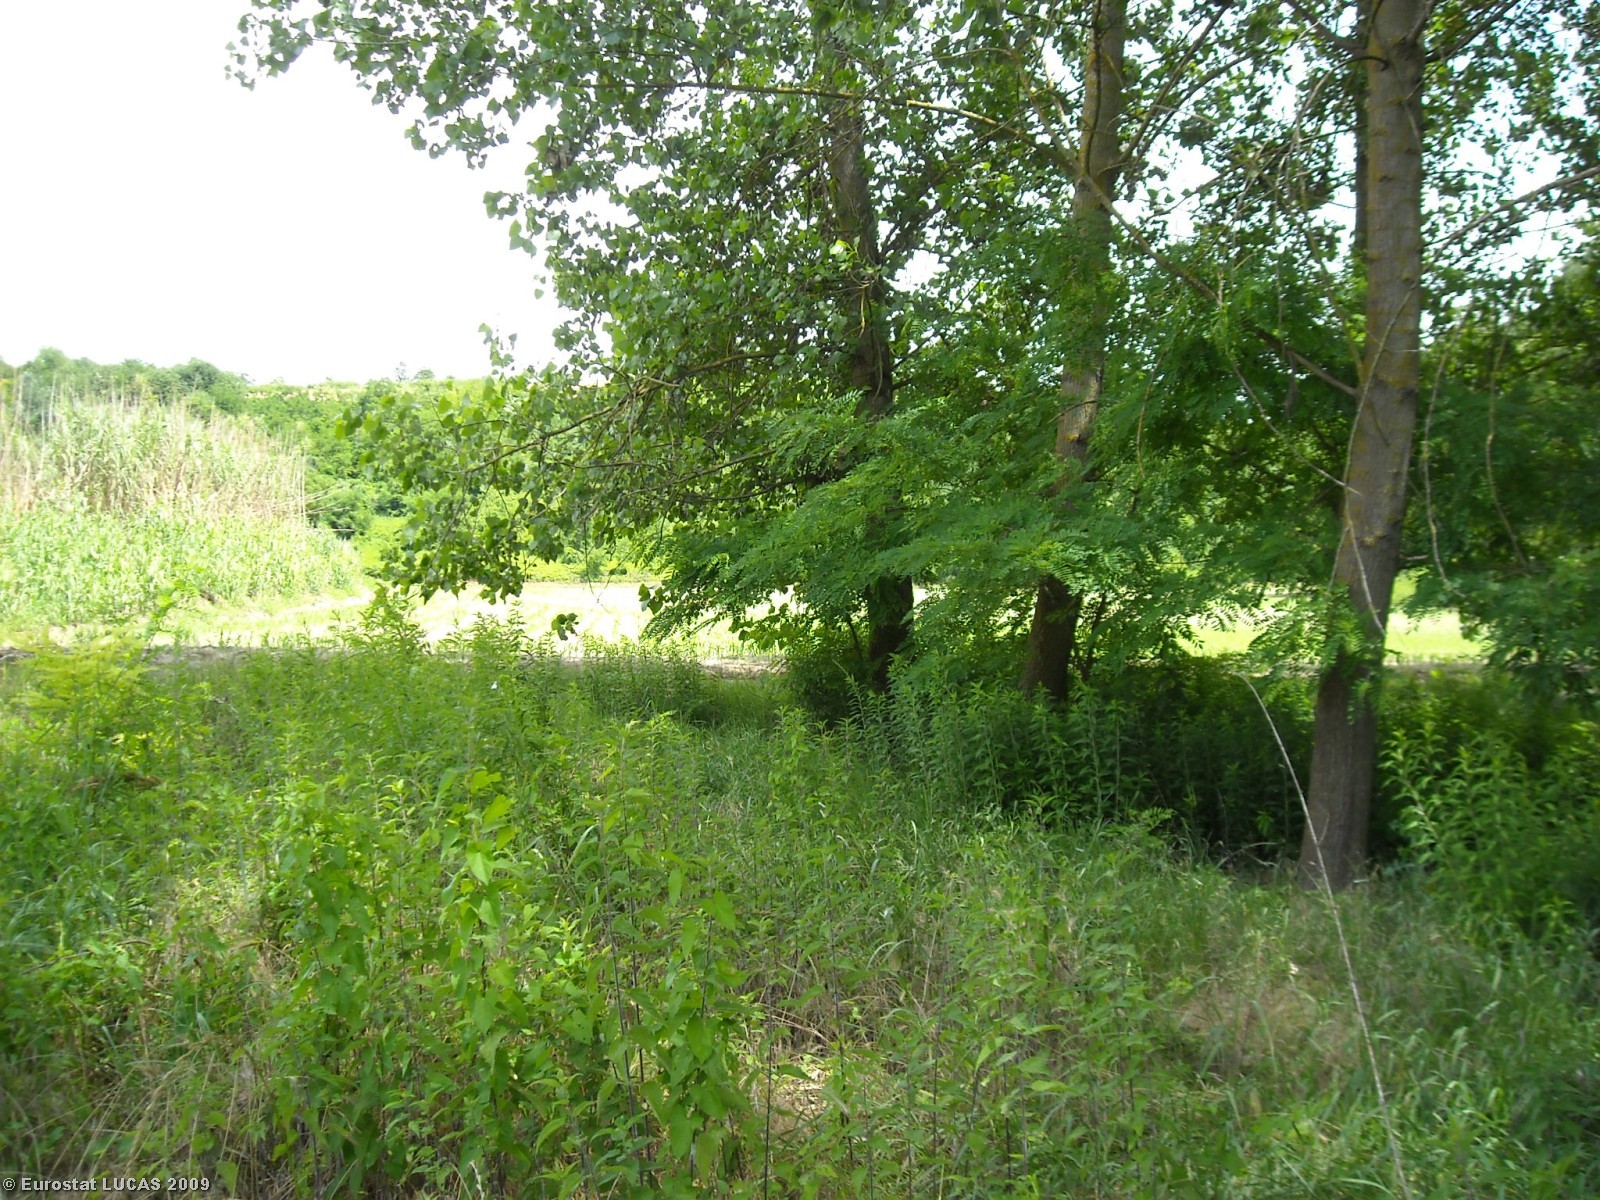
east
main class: Grassland
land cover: Spontaneously vegetated surfaces
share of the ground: > 75 %
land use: Fallow land
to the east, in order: Spontaneously vegetated surfaces; Broadleaved woodland; Tracks; Maize; Spontaneously vegetated surfaces
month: June
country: IT
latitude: 45.0003
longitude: 8.0880
